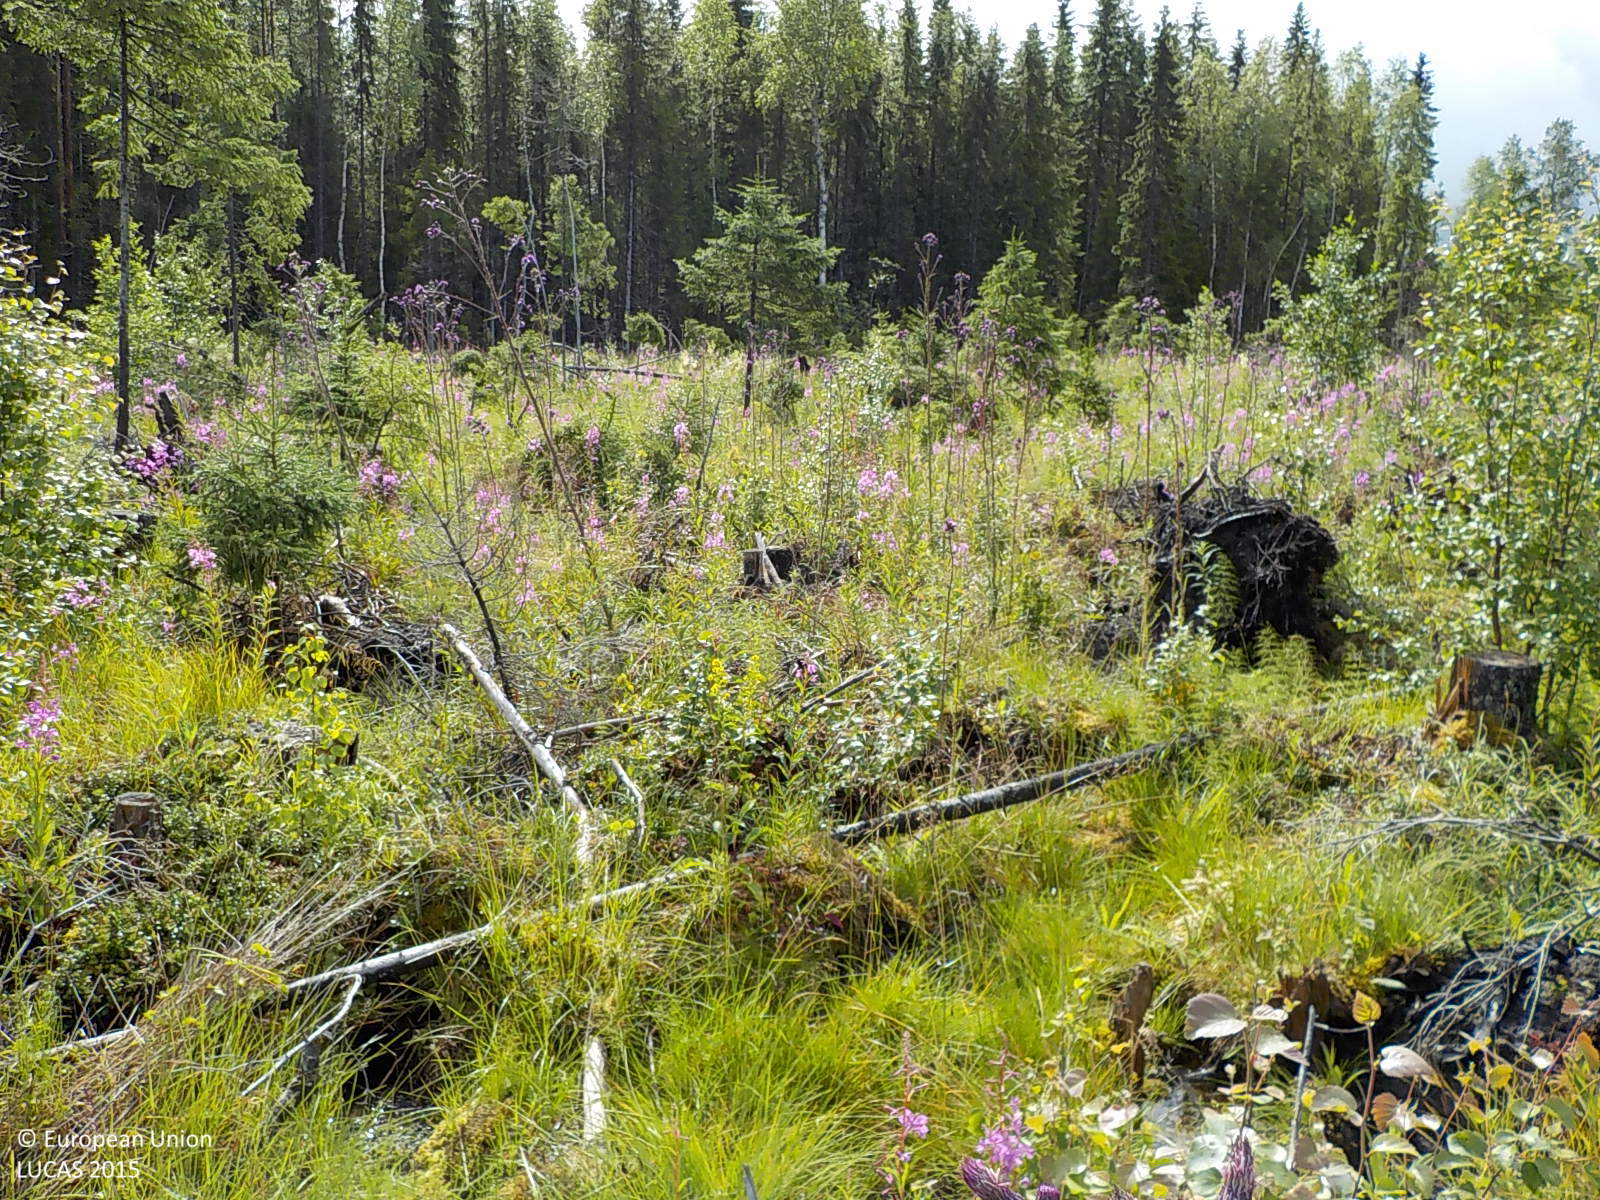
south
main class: Woodland
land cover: Broadleaved woodland
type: boreal forest
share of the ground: 50 - 75 %
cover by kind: shrubs 50 %, broadleaved forest trees 40 %, coniferous forest trees 10 %
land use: Forestry
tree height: < 5 m
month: July
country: SE
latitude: 63.2141
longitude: 16.9168
